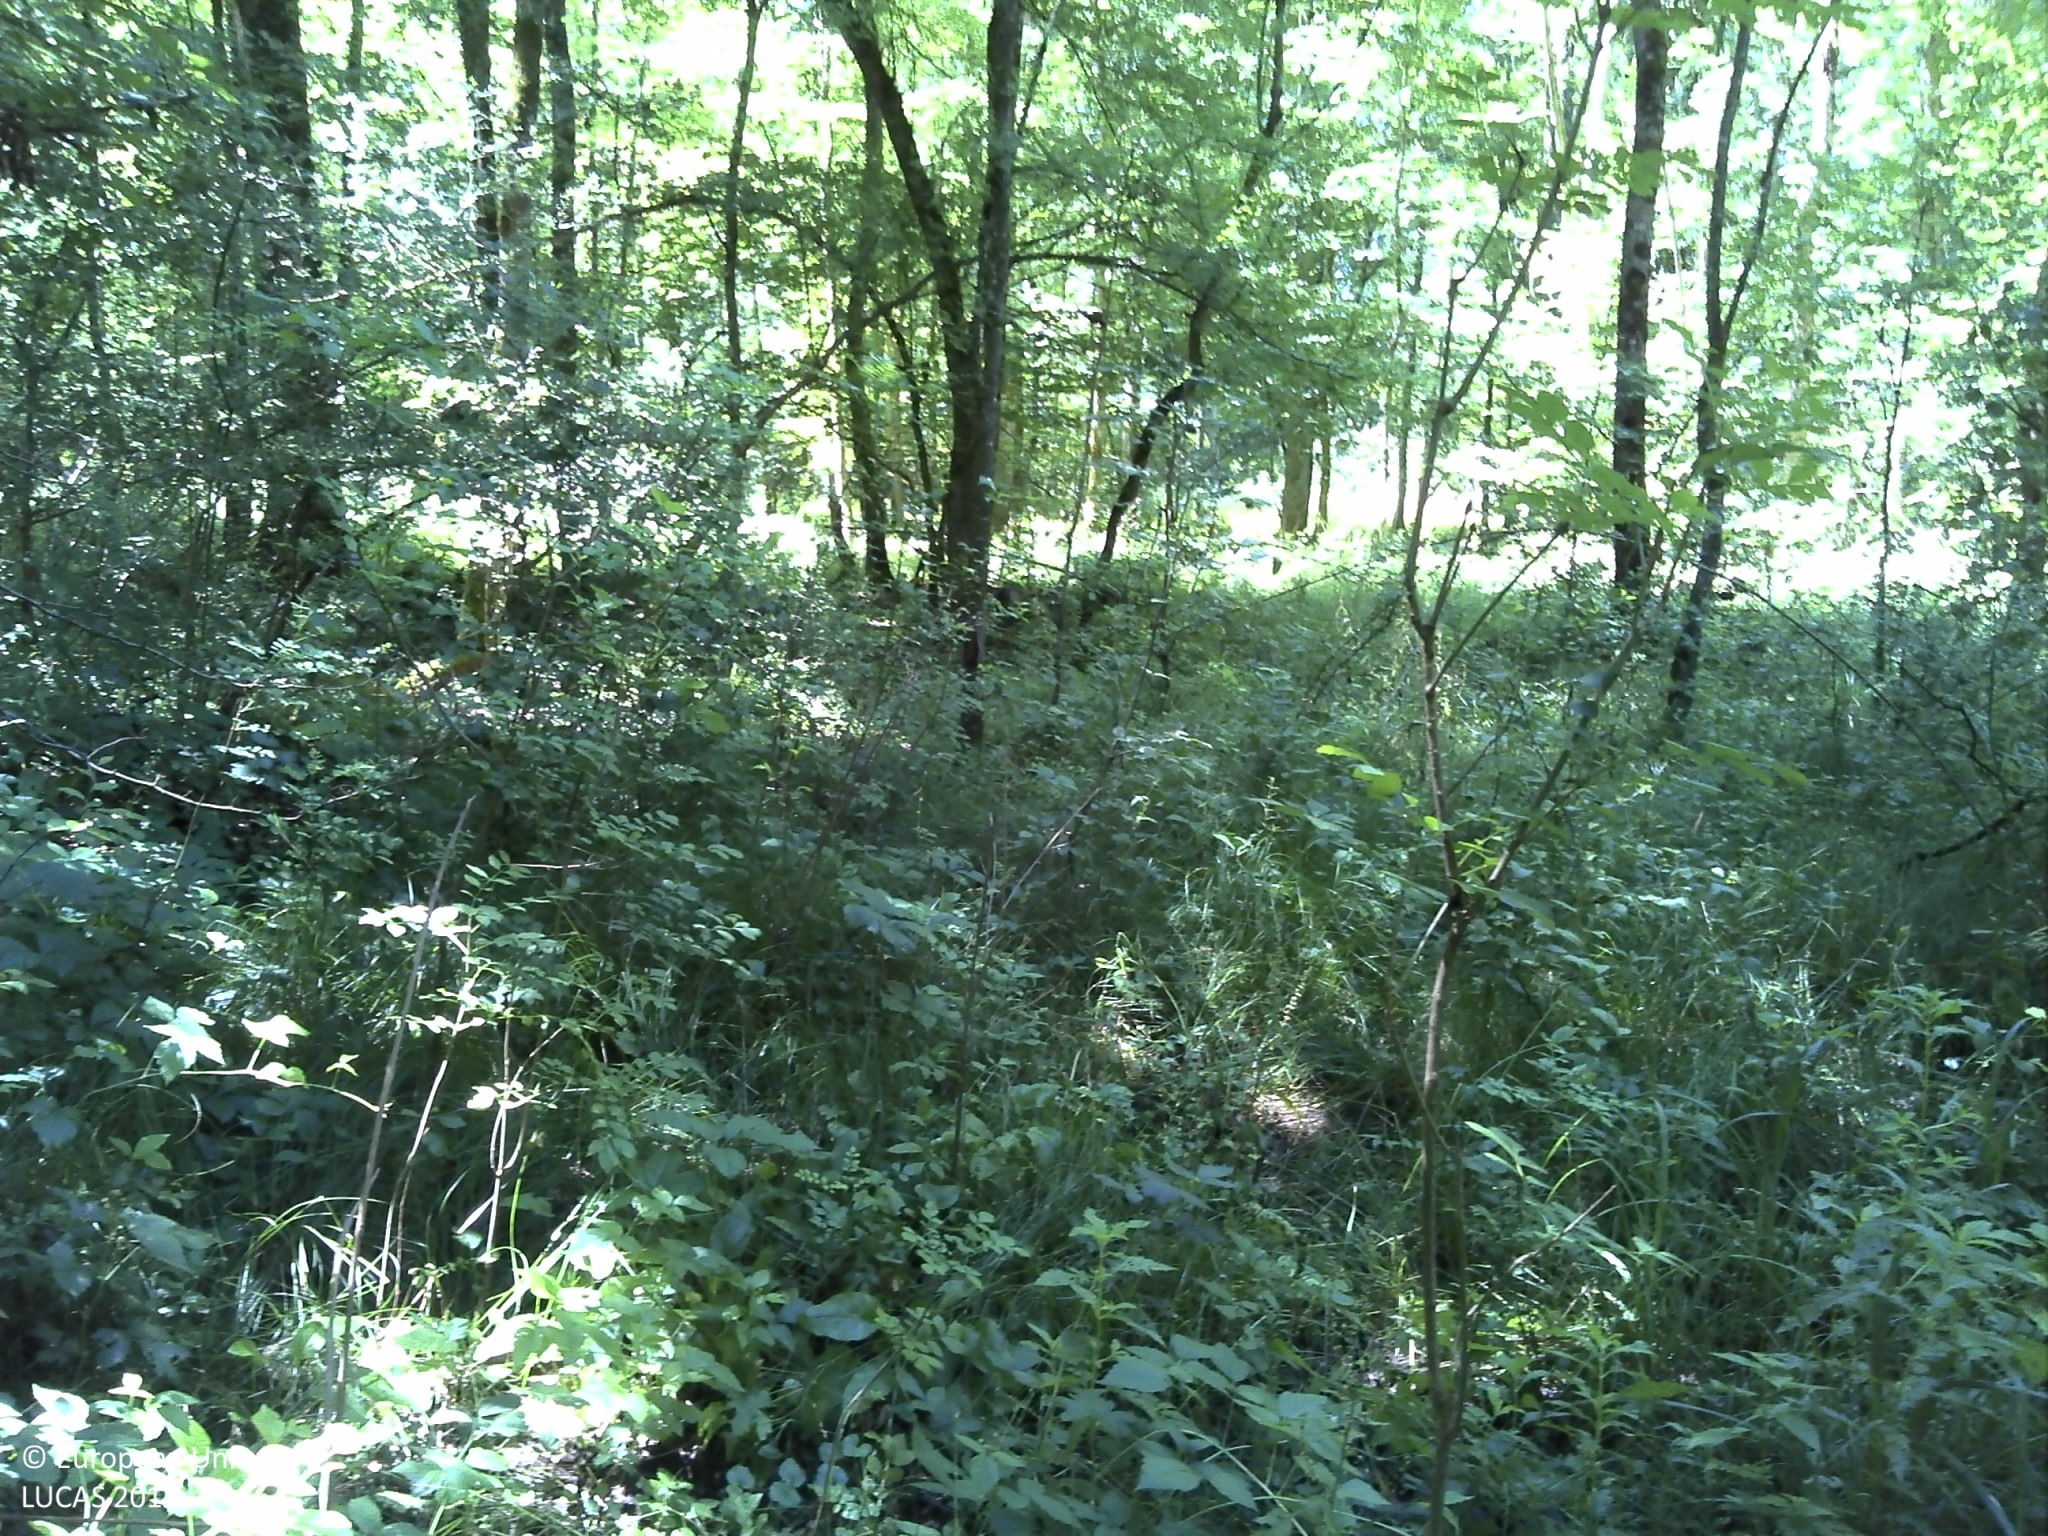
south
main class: Woodland
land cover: Broadleaved woodland
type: acidophilous oak and oak-birch forest
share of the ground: > 75 %
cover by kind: broadleaved forest trees 90 %, shrubs 5 %, herbaceous plants 5 %
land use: Forestry
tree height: > 5 m
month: June
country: HR
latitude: 45.7259
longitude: 17.7514
